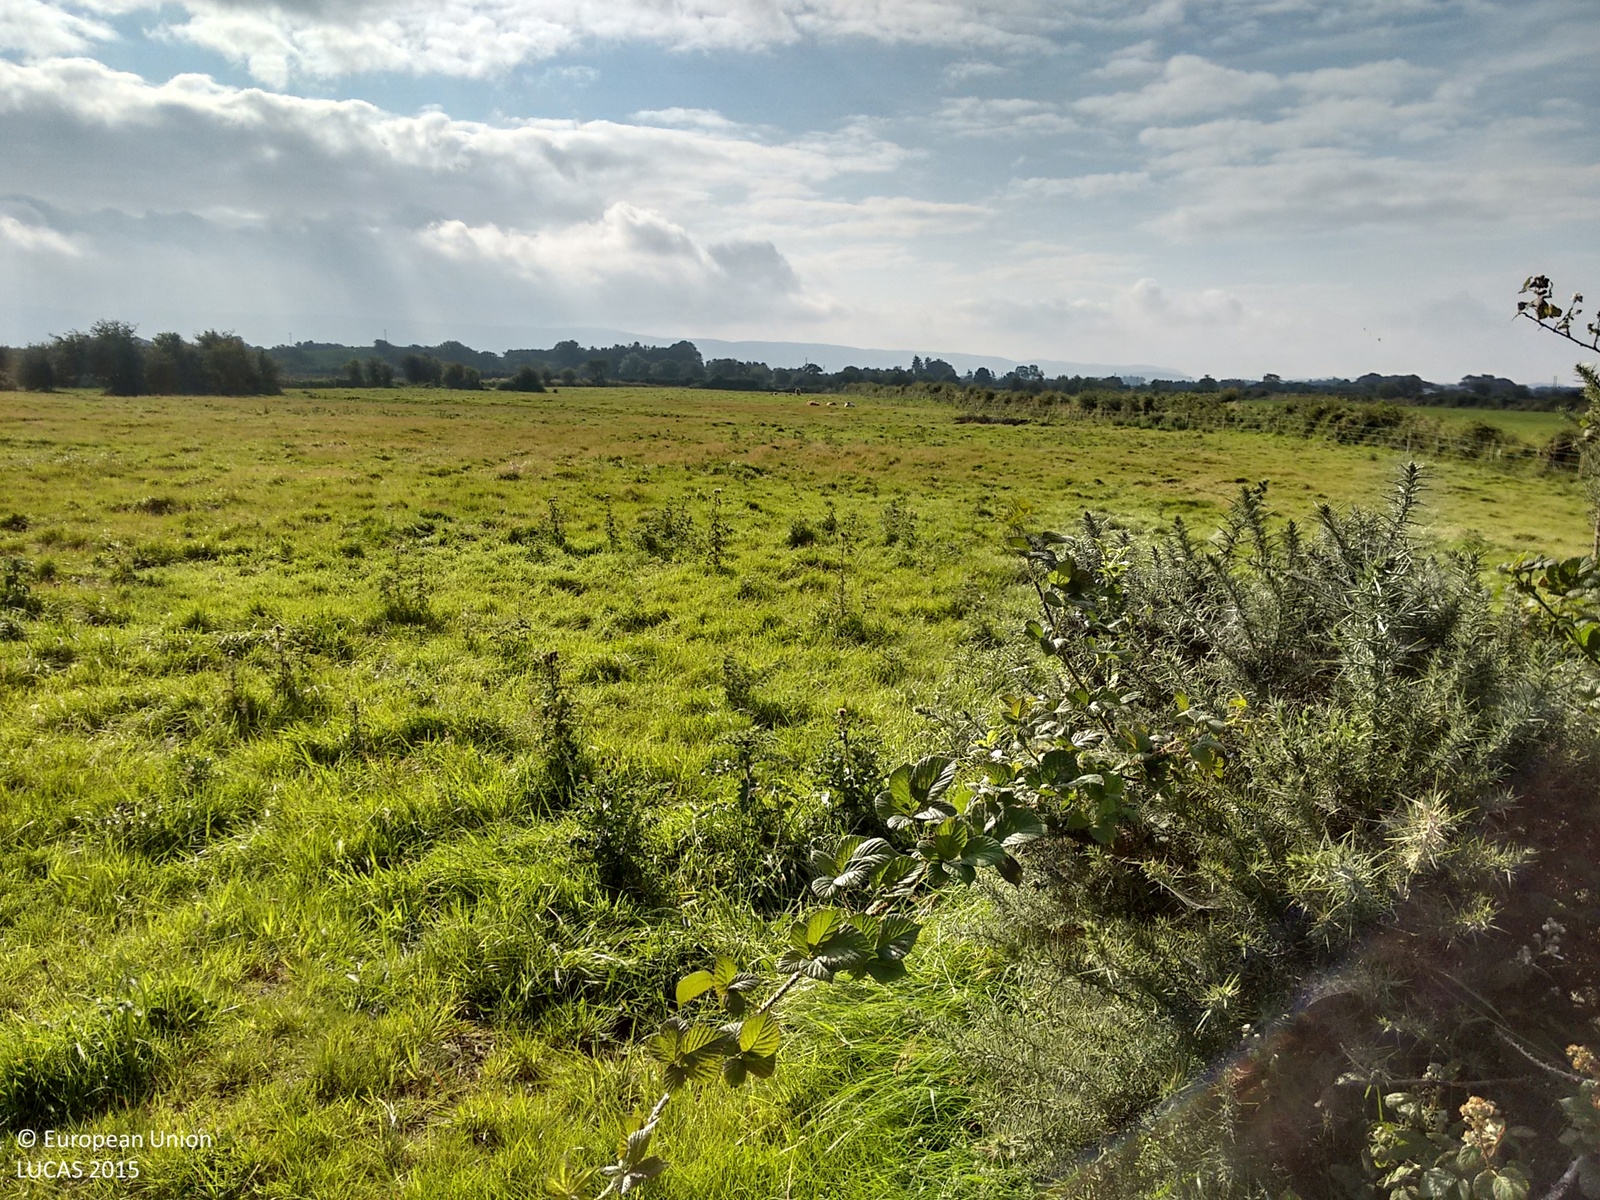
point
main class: Grassland
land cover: Grassland without tree/shrub cover
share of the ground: > 75 %
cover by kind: herbaceous plants 100 %
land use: Agriculture (excluding fallow land and kitchen gardens)
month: September
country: IE
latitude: 54.1226
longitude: -9.0802
